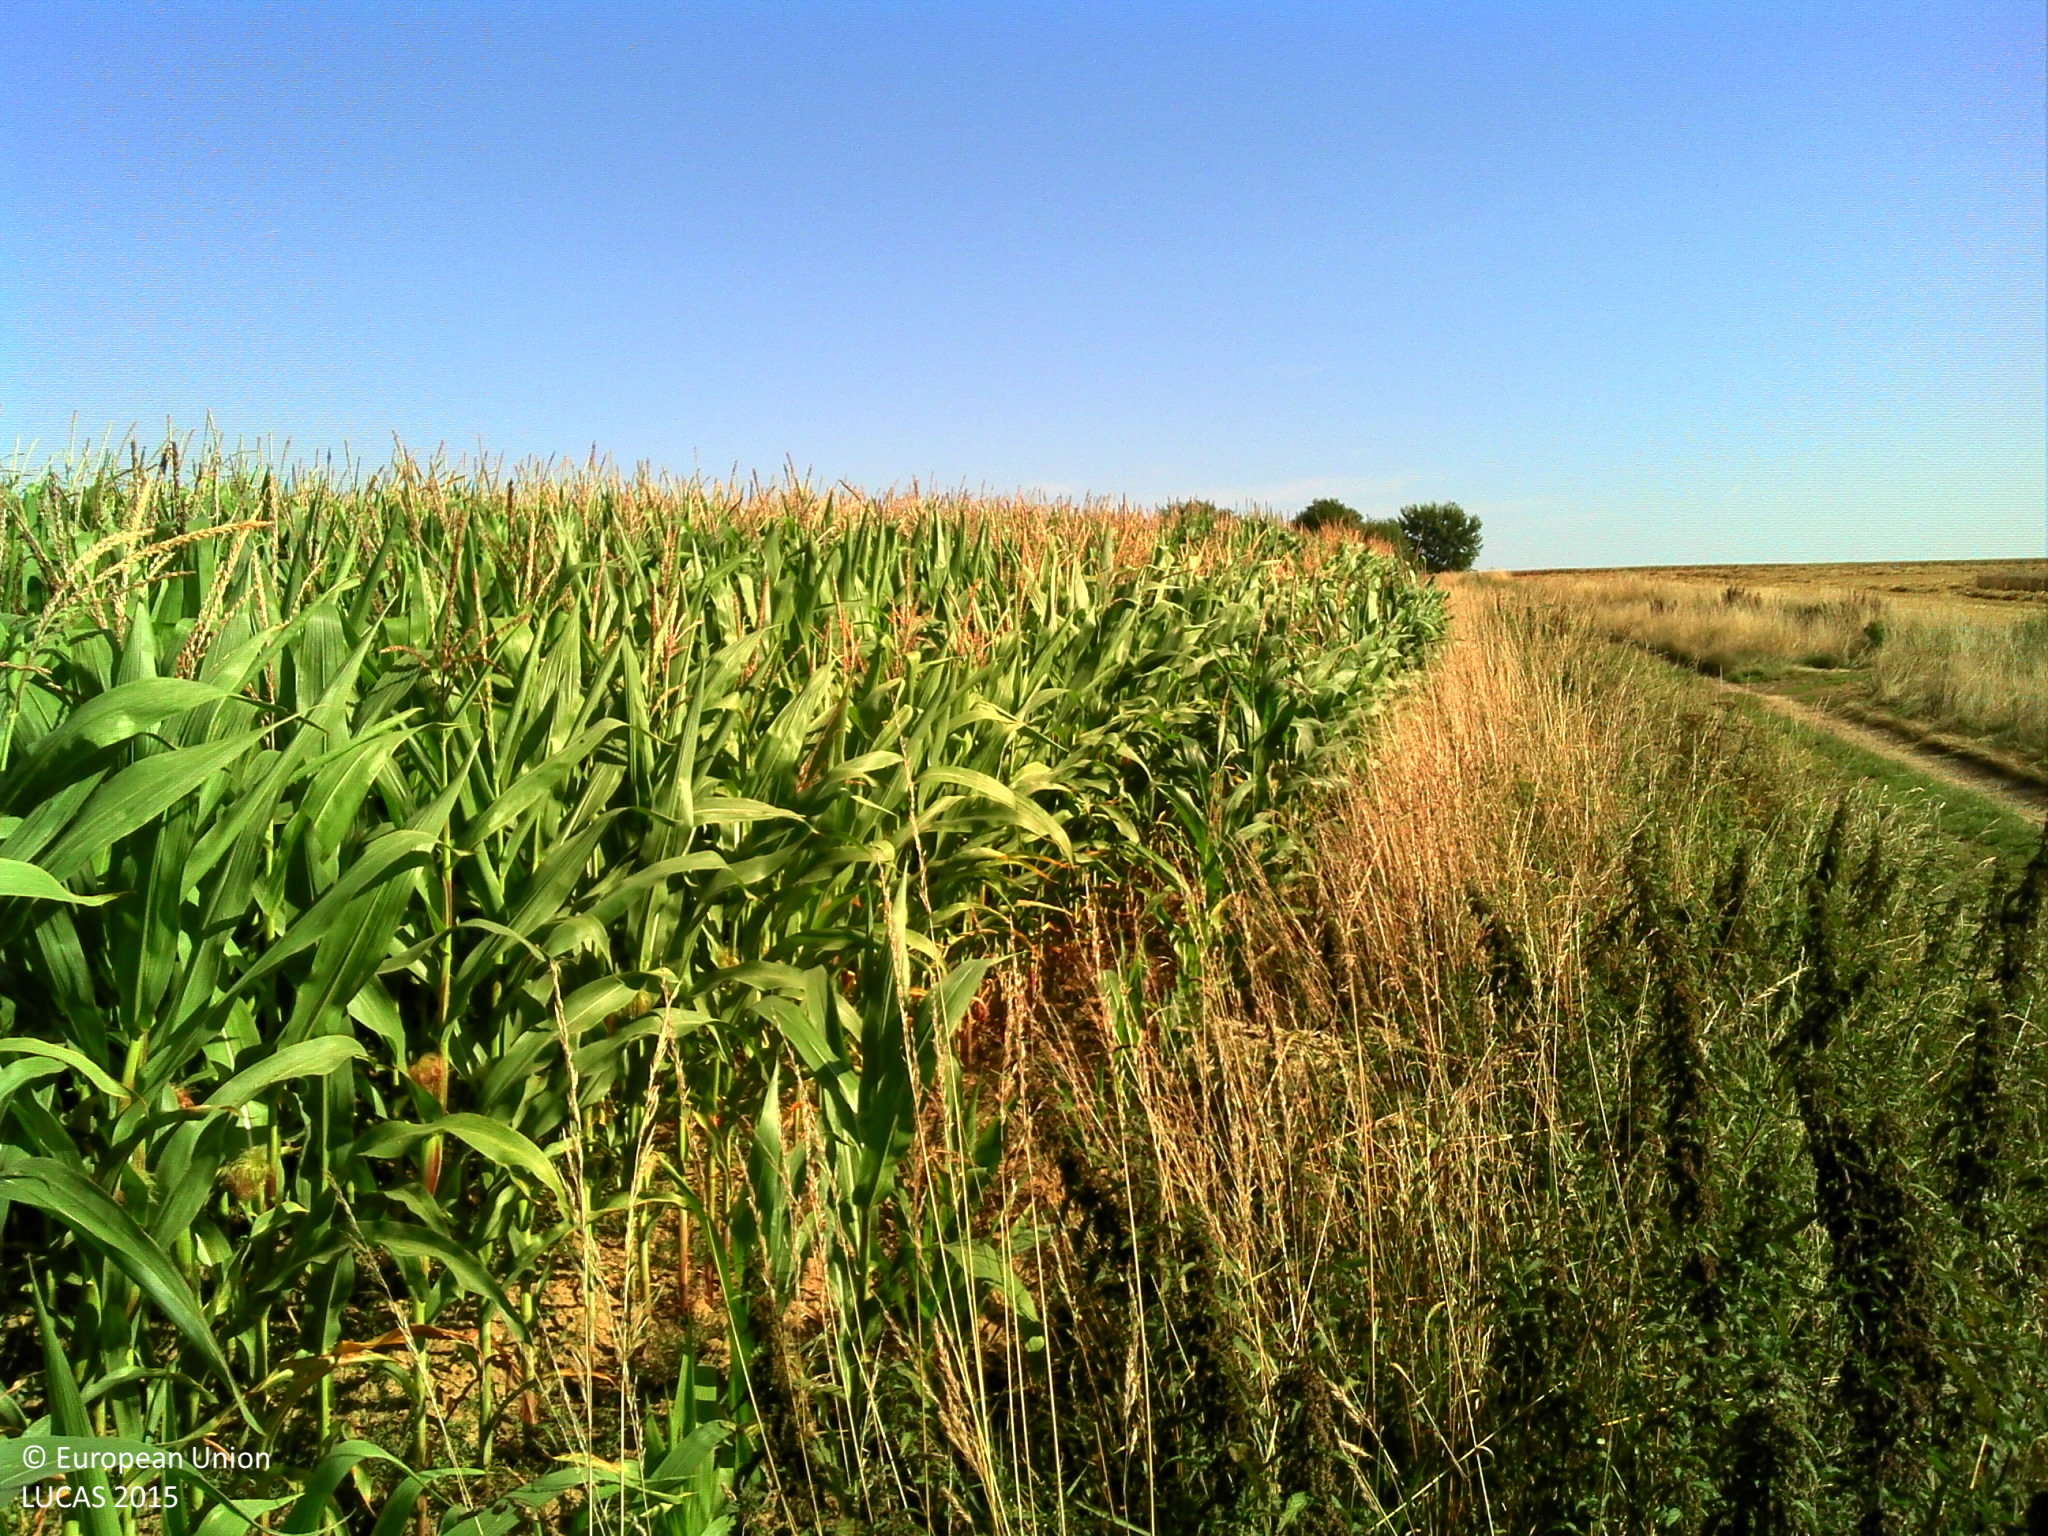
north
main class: Cropland
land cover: Maize
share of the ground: > 75 %
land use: Agriculture (excluding fallow land and kitchen gardens)
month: August
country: FR
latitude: 50.1684
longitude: 3.9601
